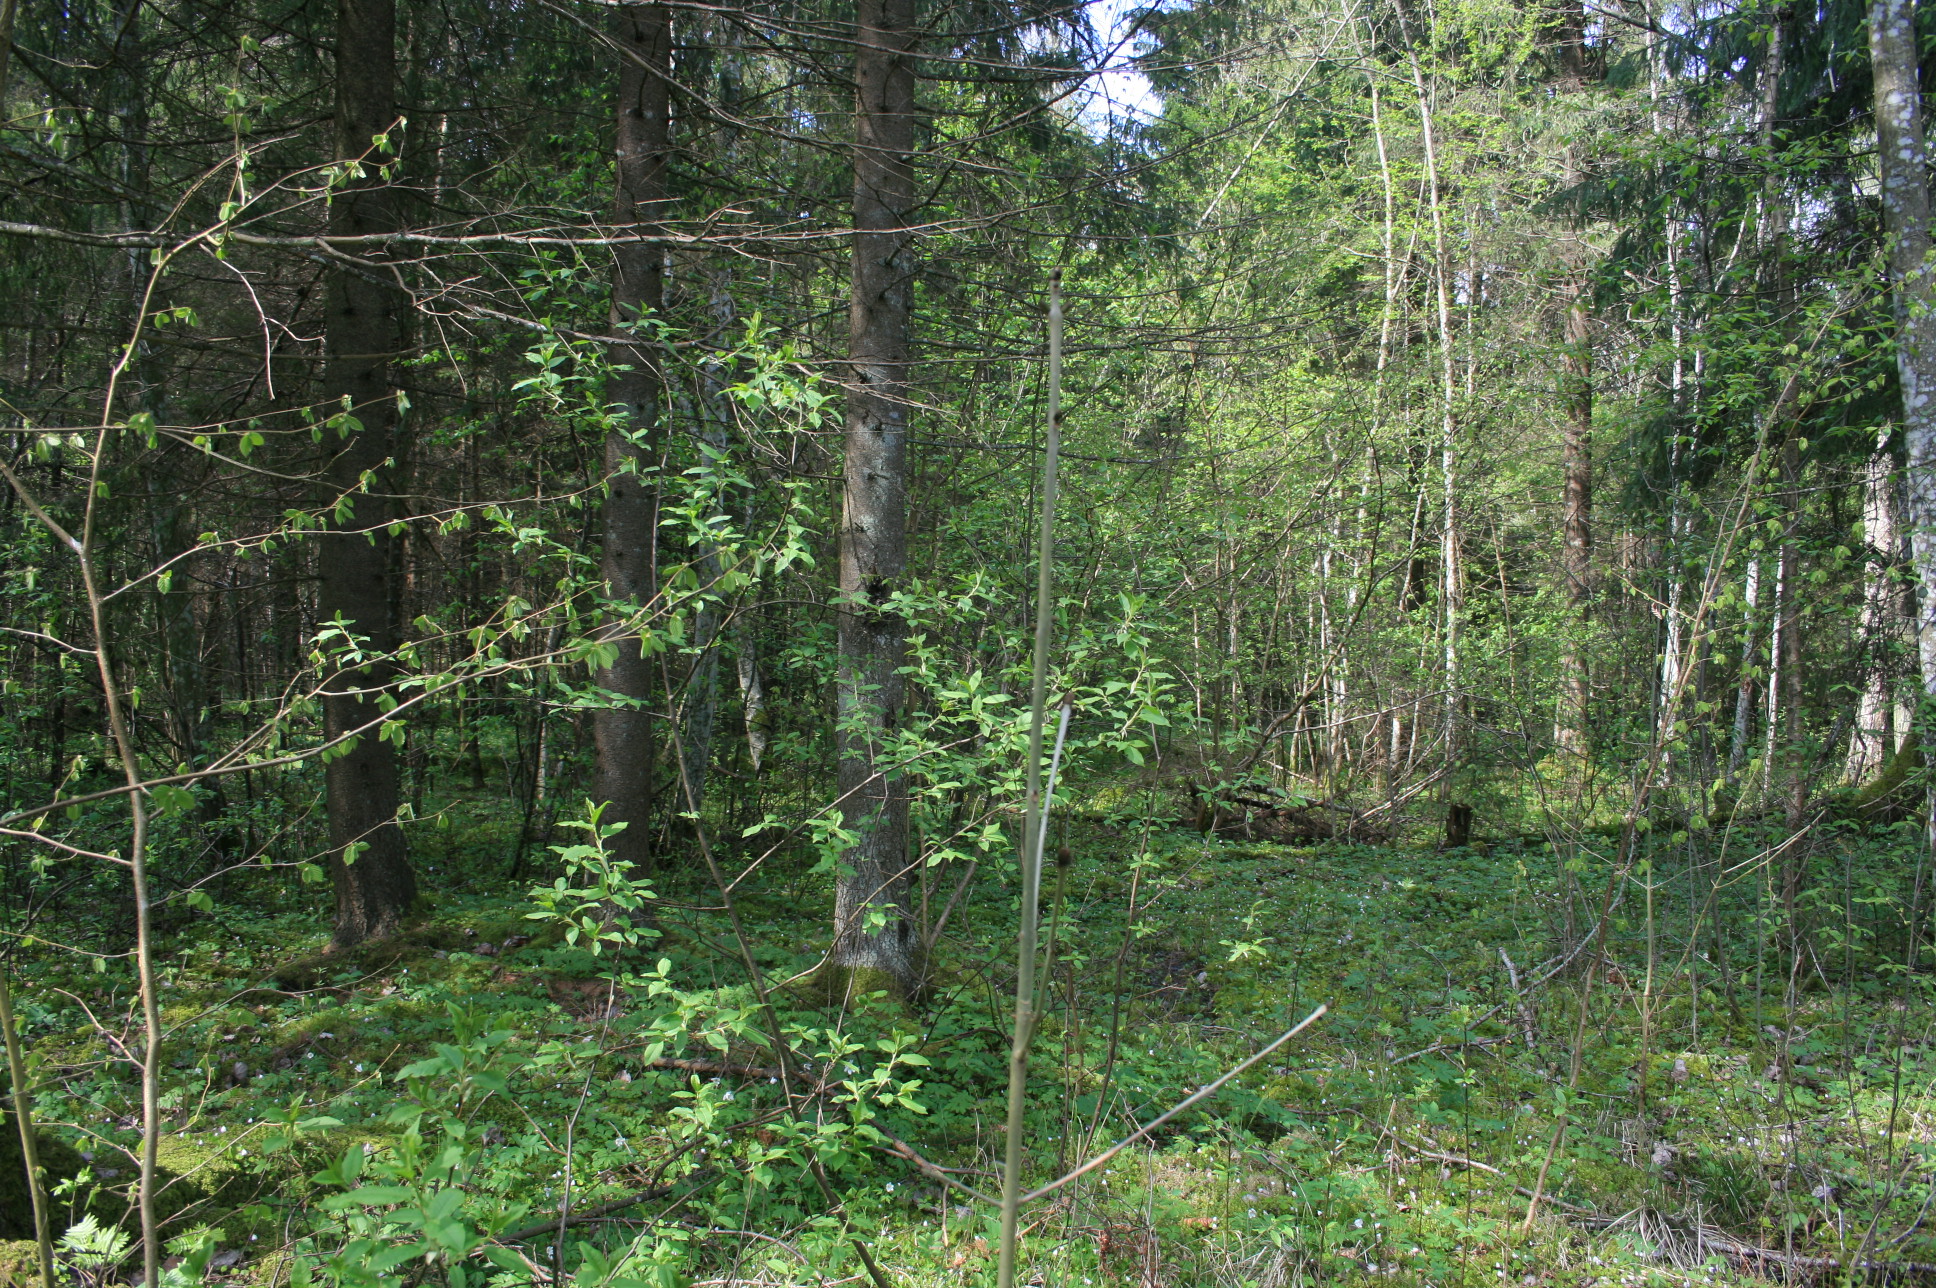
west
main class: Woodland
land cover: Spruce dominated mixed woodland
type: hemiboreal forest and nemoral coniferous forest and mixed broadleaved-coniferous forest
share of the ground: > 75 %
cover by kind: broadleaved forest trees 60 %, coniferous forest trees 40 %
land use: Forestry
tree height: > 5 m
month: May
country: LT
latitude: 56.3258
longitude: 22.0663
